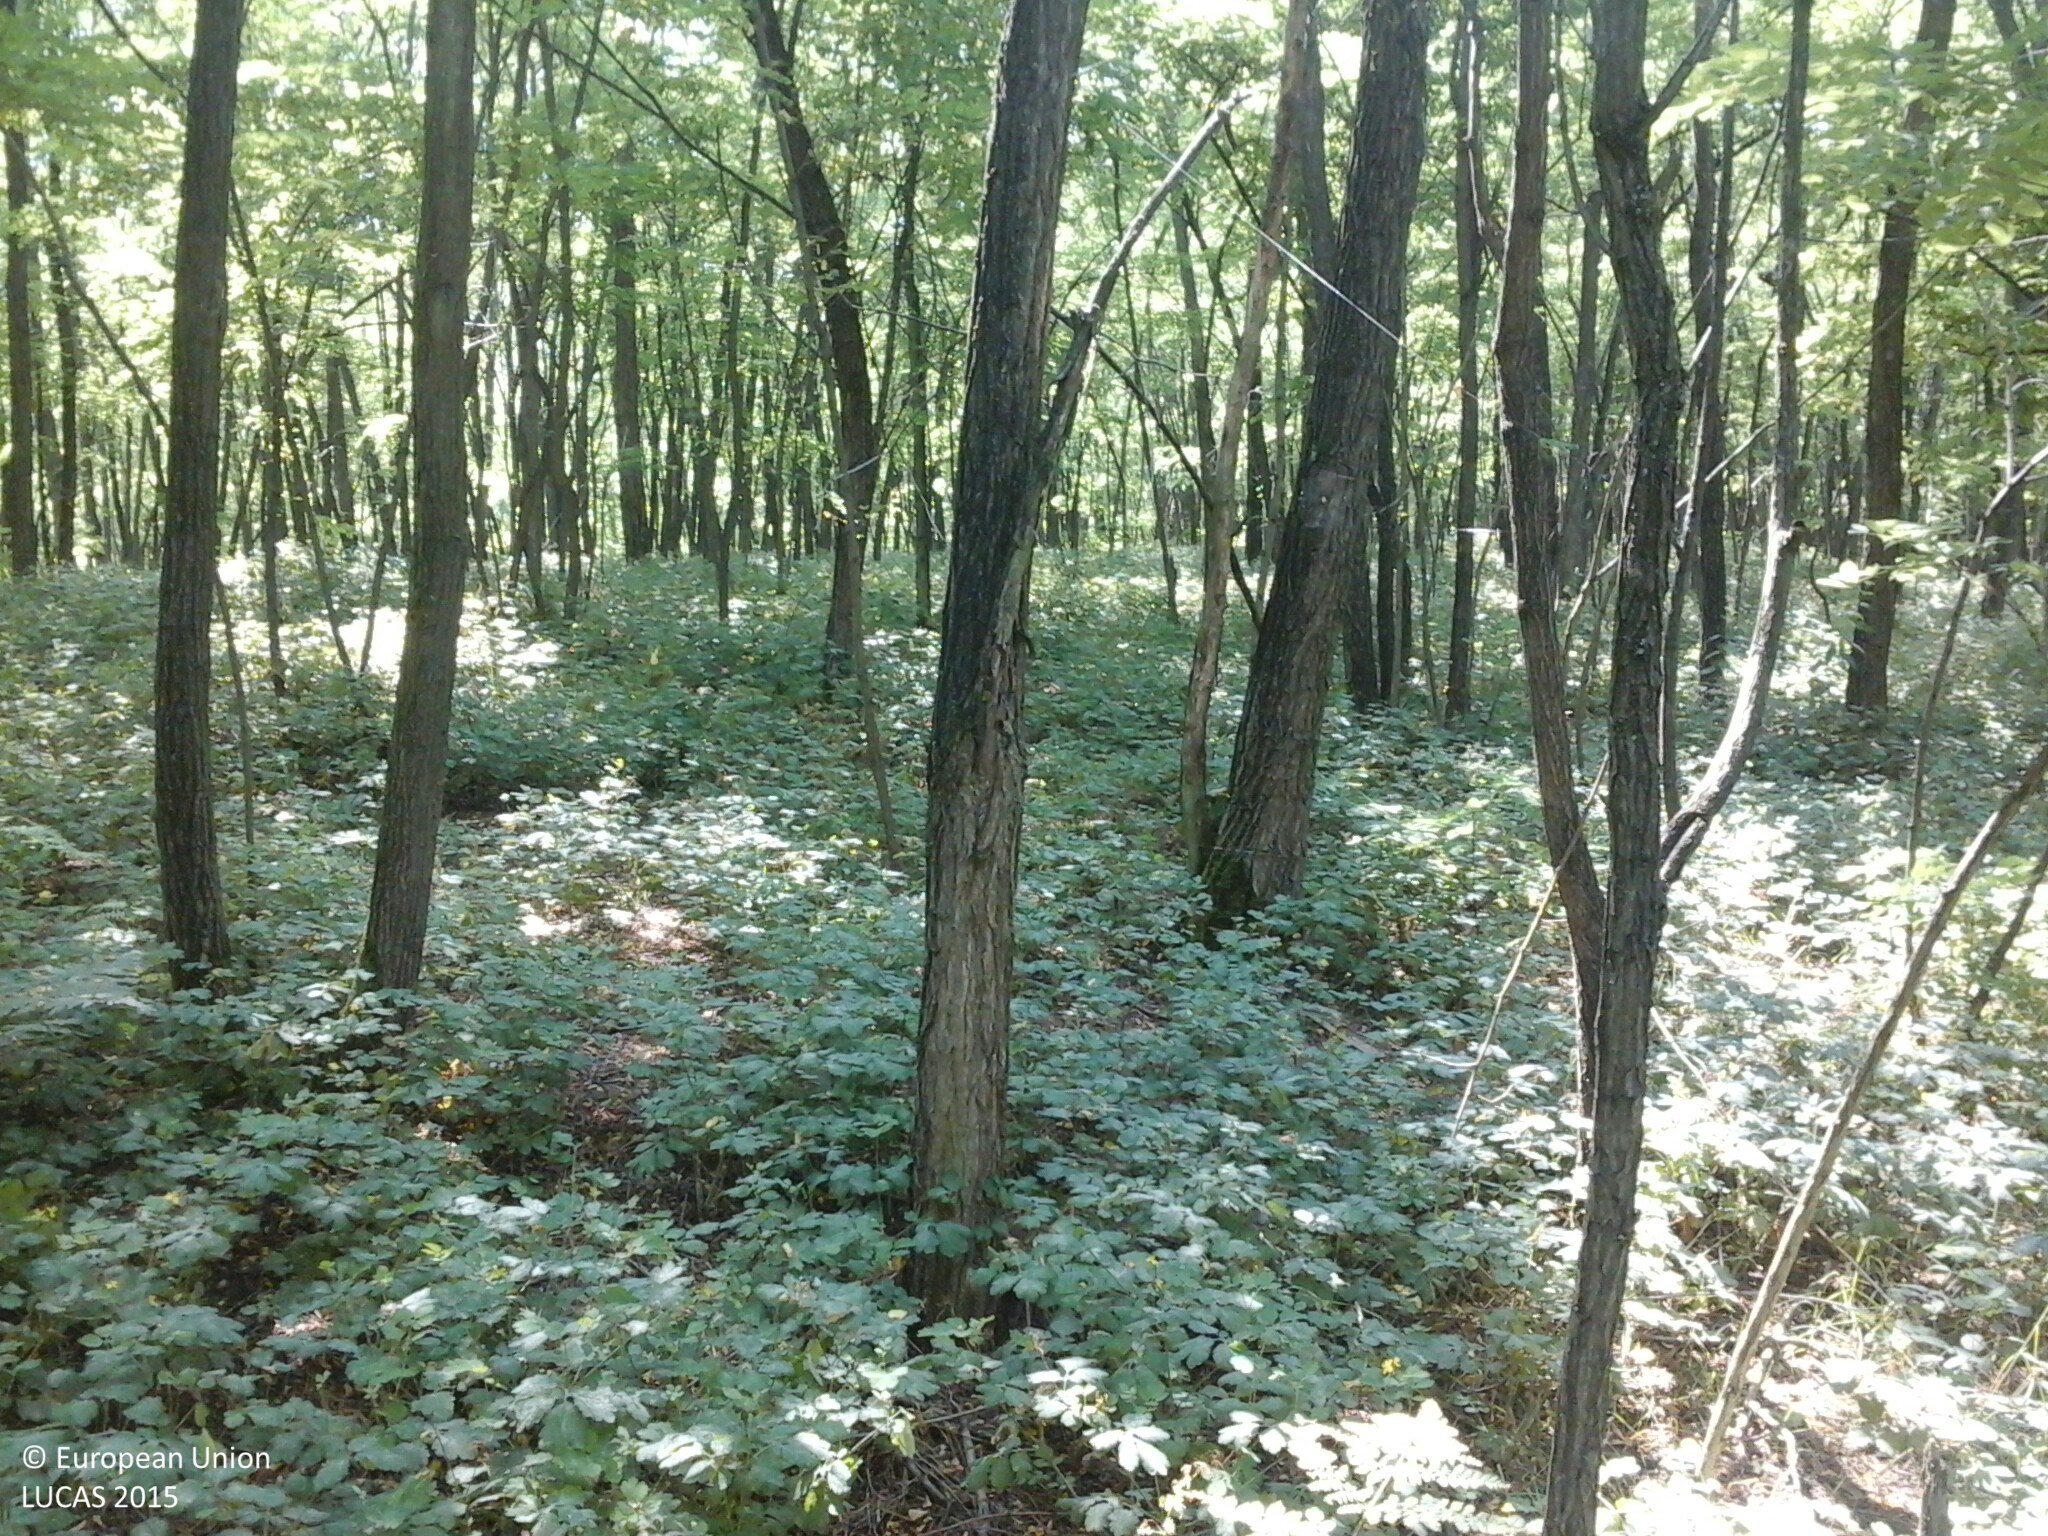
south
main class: Woodland
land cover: Broadleaved woodland
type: exotic forest
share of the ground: > 75 %
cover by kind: broadleaved forest trees 100 %
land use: Forestry
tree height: > 5 m
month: July
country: HU
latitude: 48.1414
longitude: 22.2184
